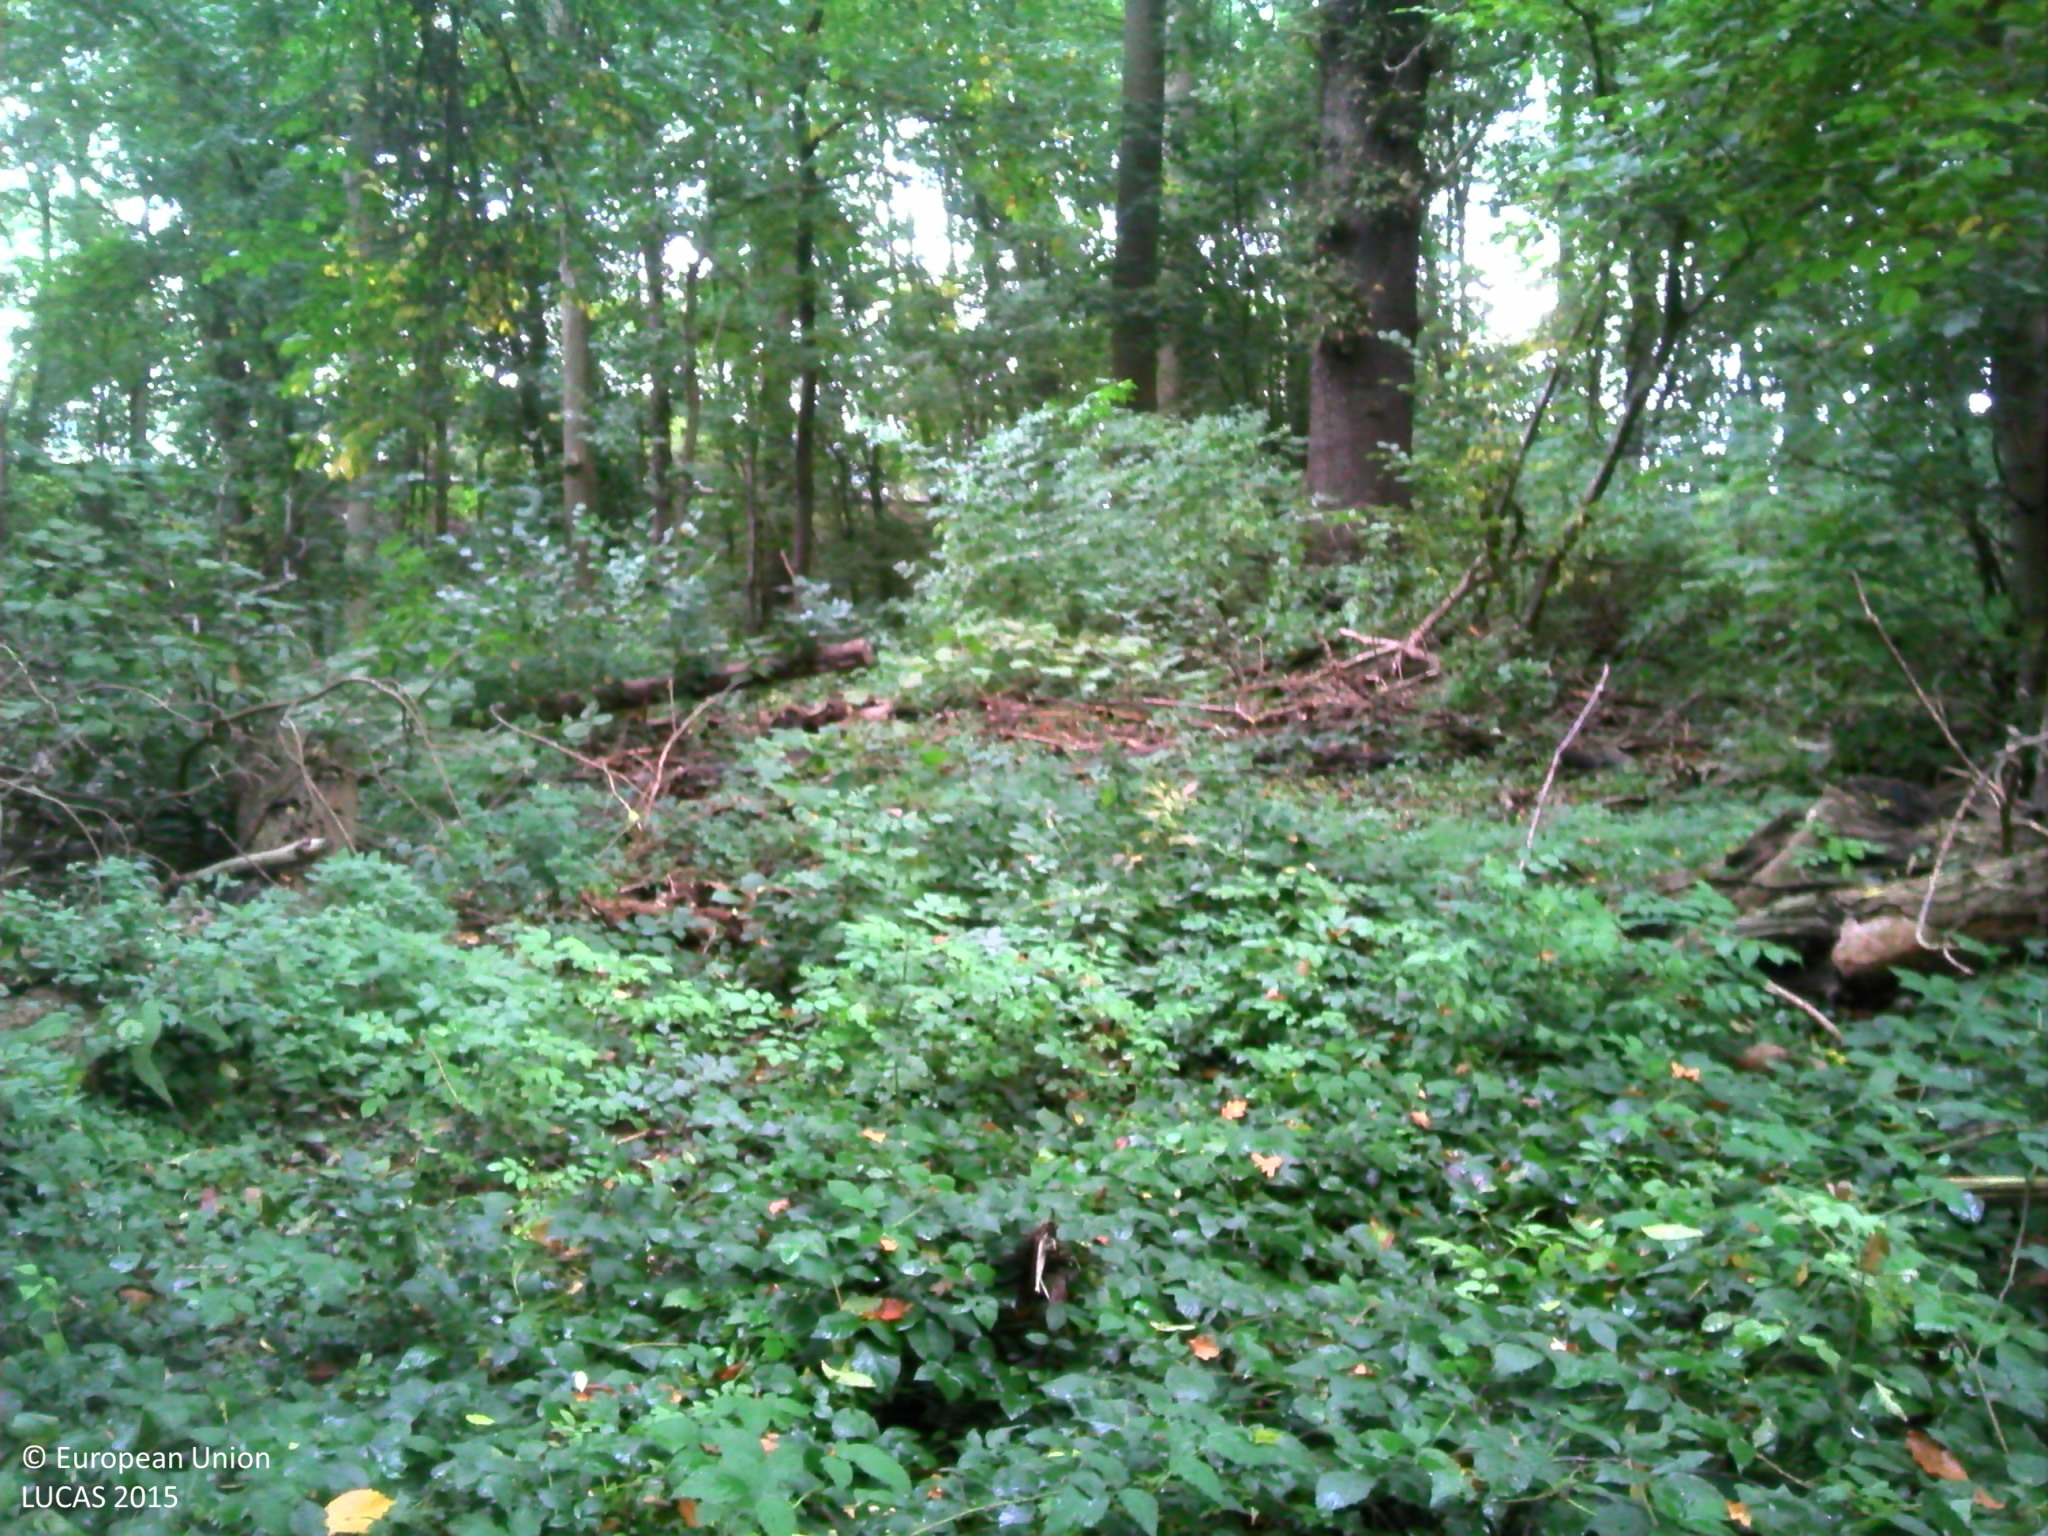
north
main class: Woodland
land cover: Broadleaved woodland
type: mesophytic deciduous forest
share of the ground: > 75 %
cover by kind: broadleaved forest trees 60 %, herbaceous plants 30 %, shrubs 10 %
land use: Forestry
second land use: Amenities, museums, leisure
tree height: > 5 m
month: October
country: BE
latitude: 50.8886
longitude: 4.2947
